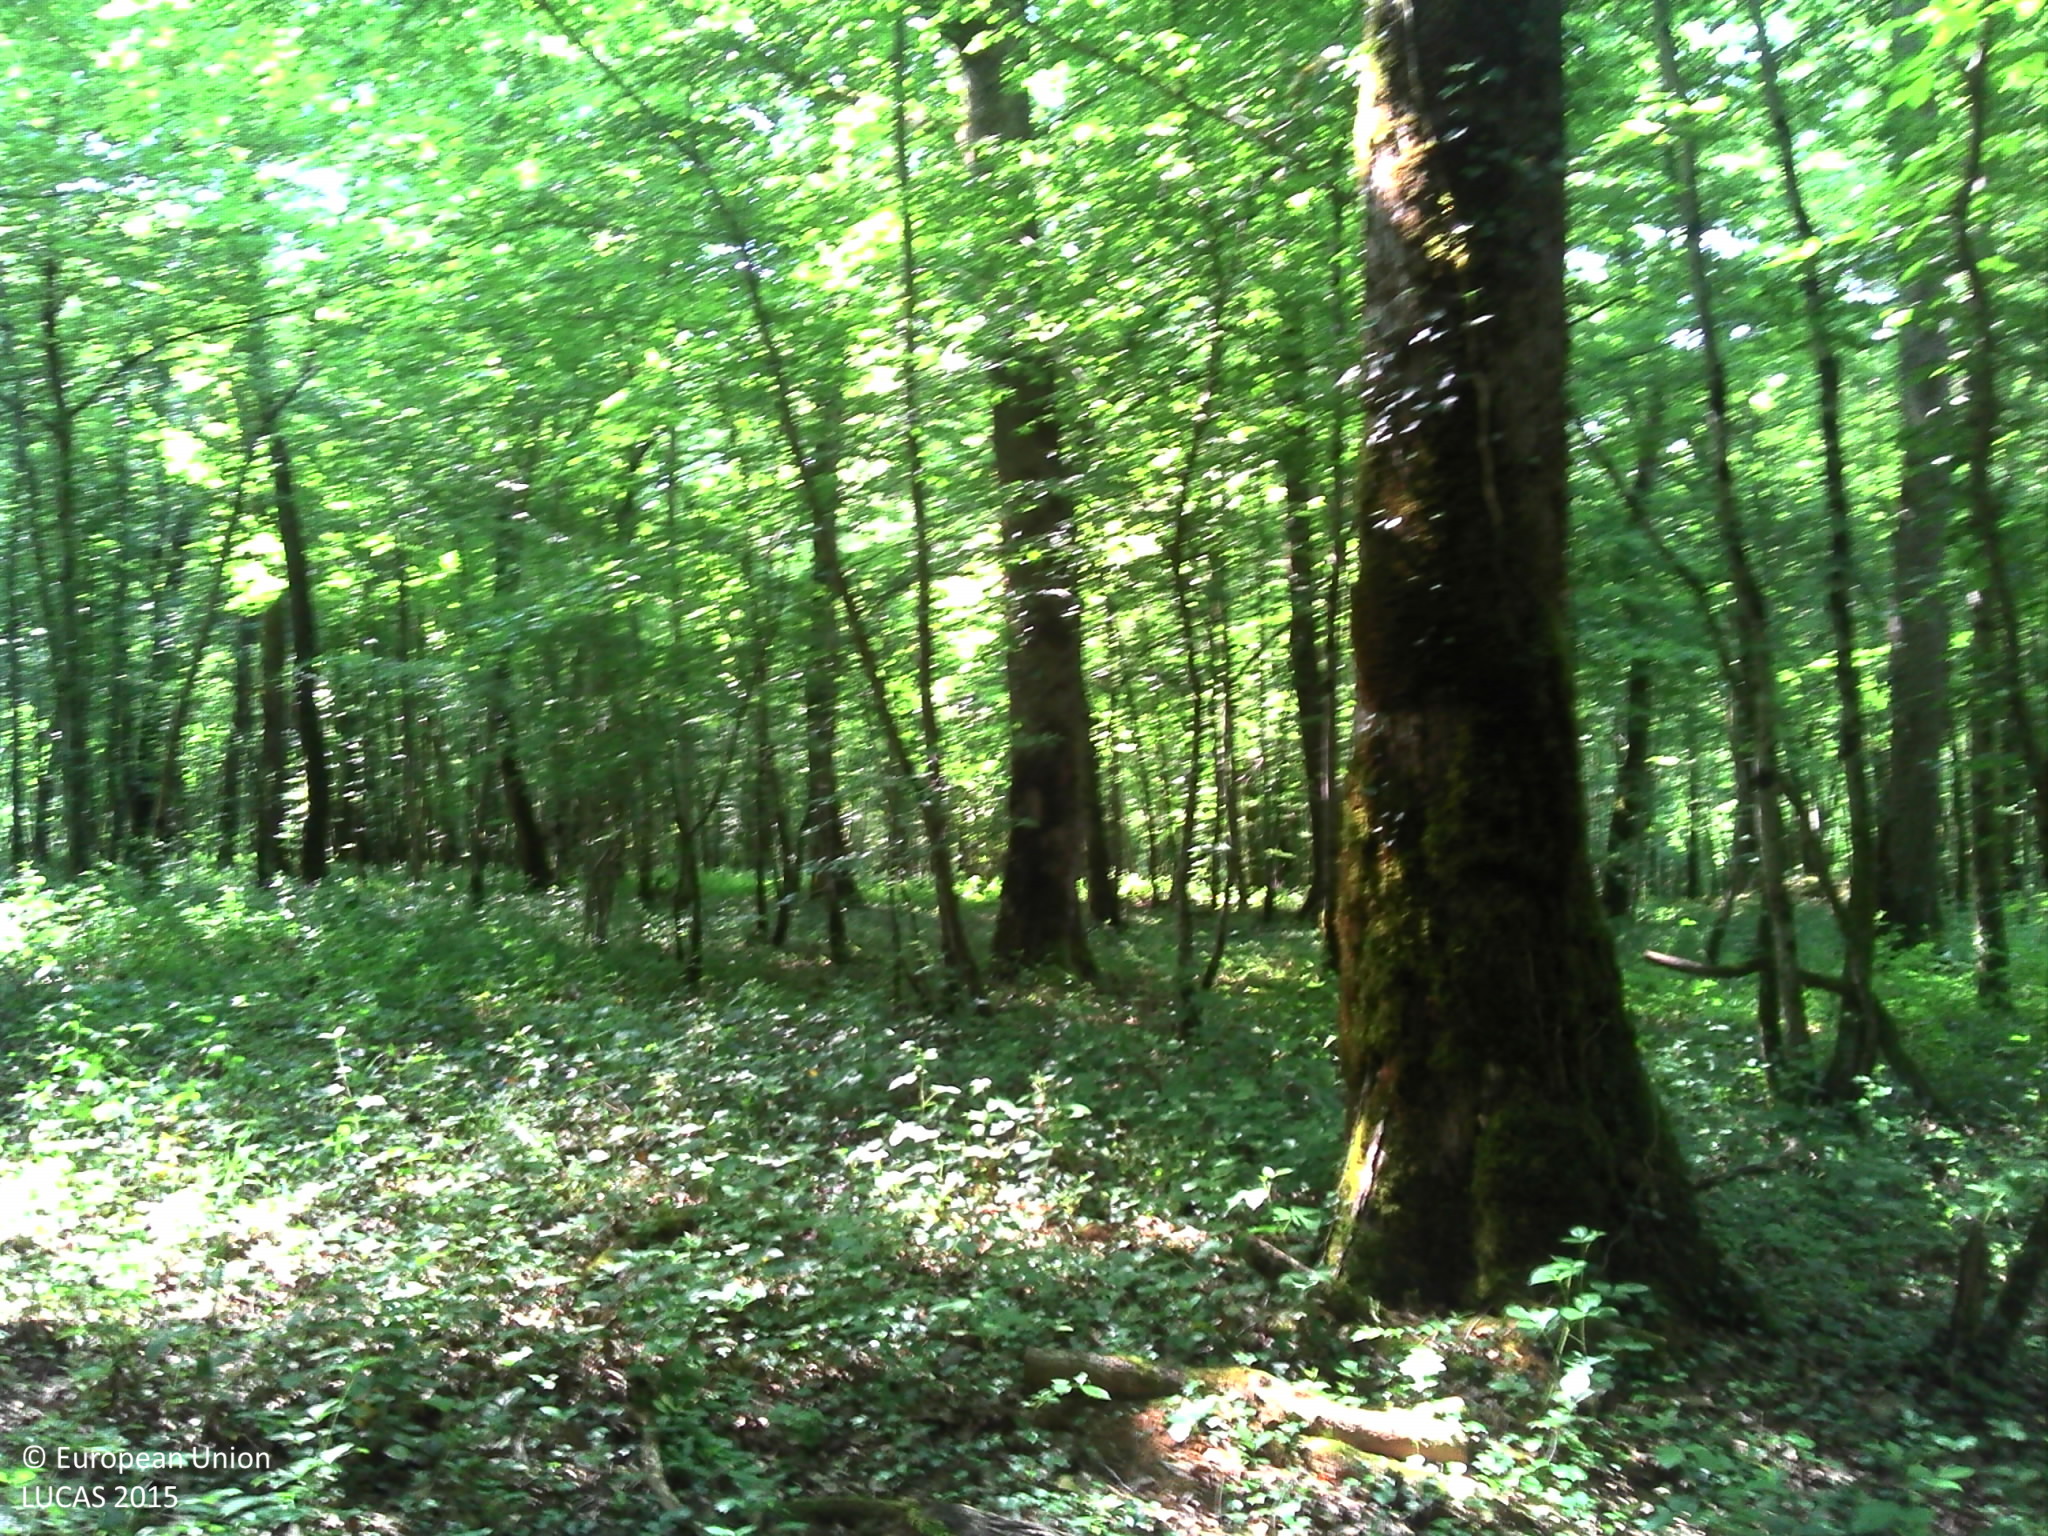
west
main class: Woodland
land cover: Broadleaved woodland
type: beech forest
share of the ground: > 75 %
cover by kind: broadleaved forest trees 95 %, herbaceous plants 5 %
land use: Forestry
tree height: > 5 m
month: June
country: FR
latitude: 47.5667
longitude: 6.2930
